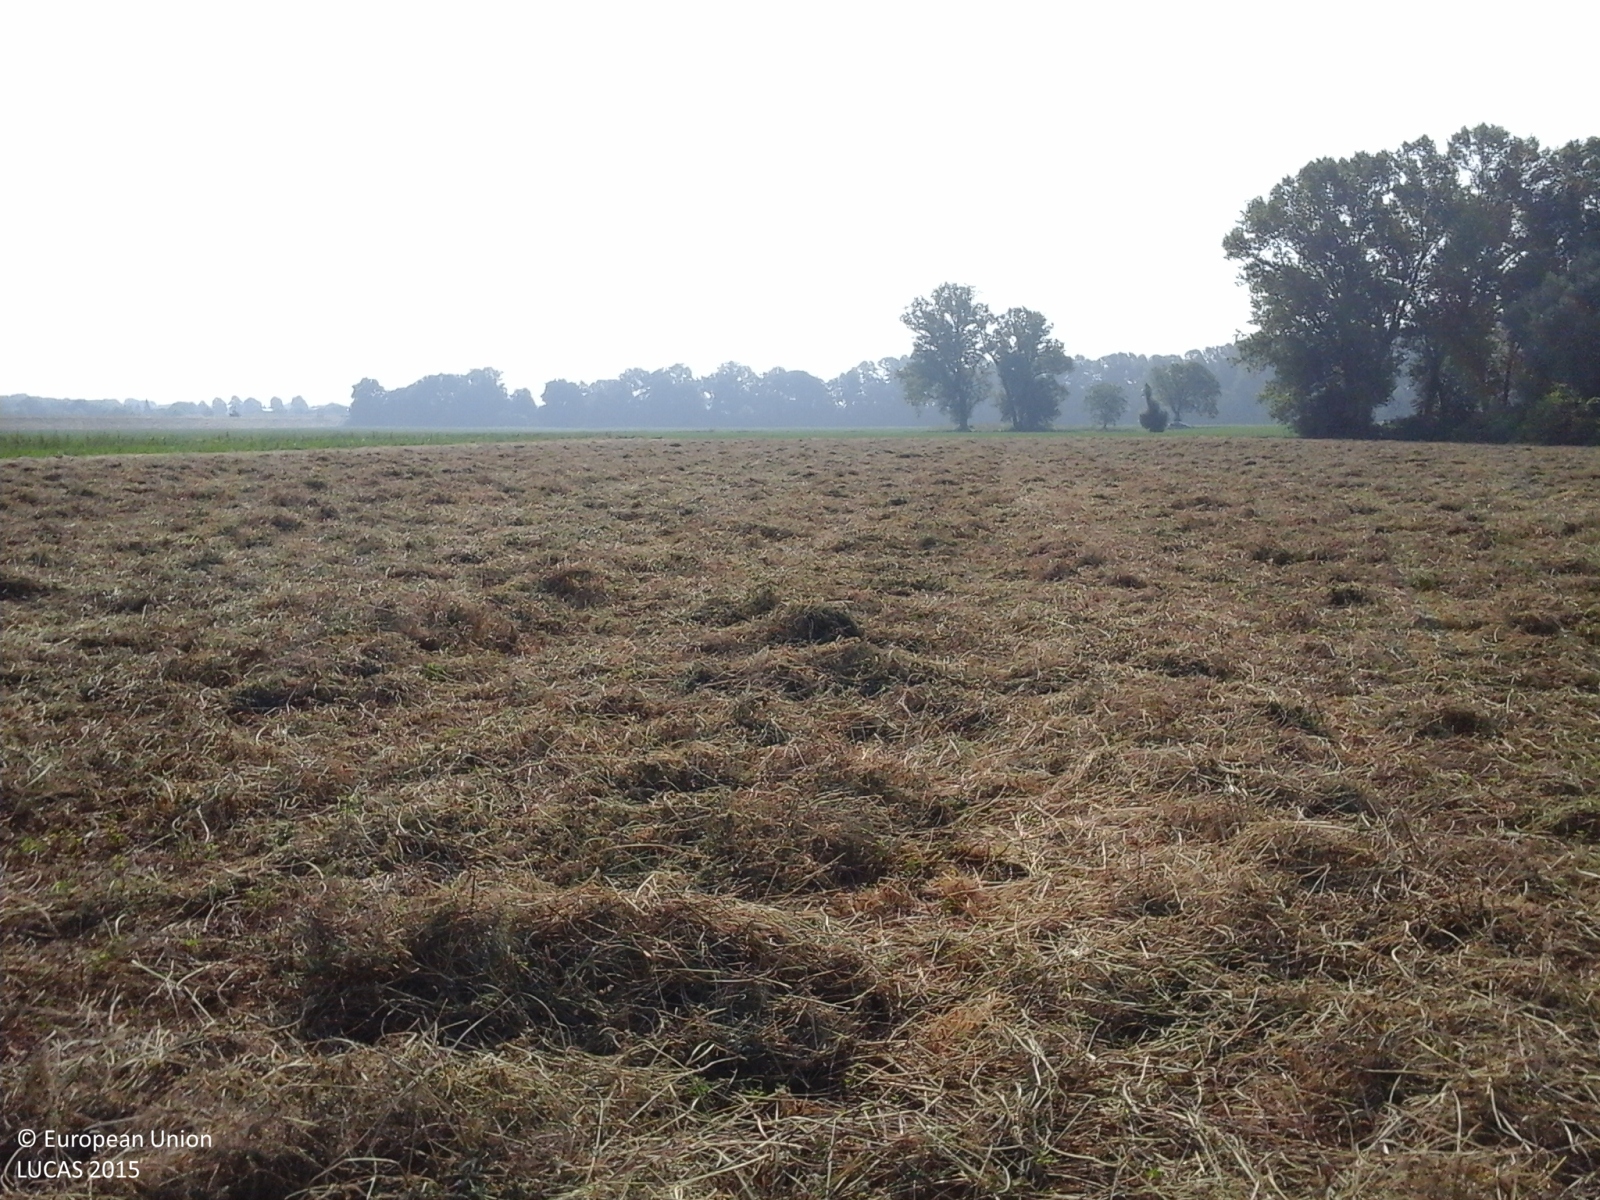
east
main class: Cropland
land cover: Lucerne
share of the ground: > 75 %
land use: Agriculture (excluding fallow land and kitchen gardens)
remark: Harvested field
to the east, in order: Lucerne; Grass margins; Lucerne
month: June
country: IT
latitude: 45.0175
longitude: 10.2153
